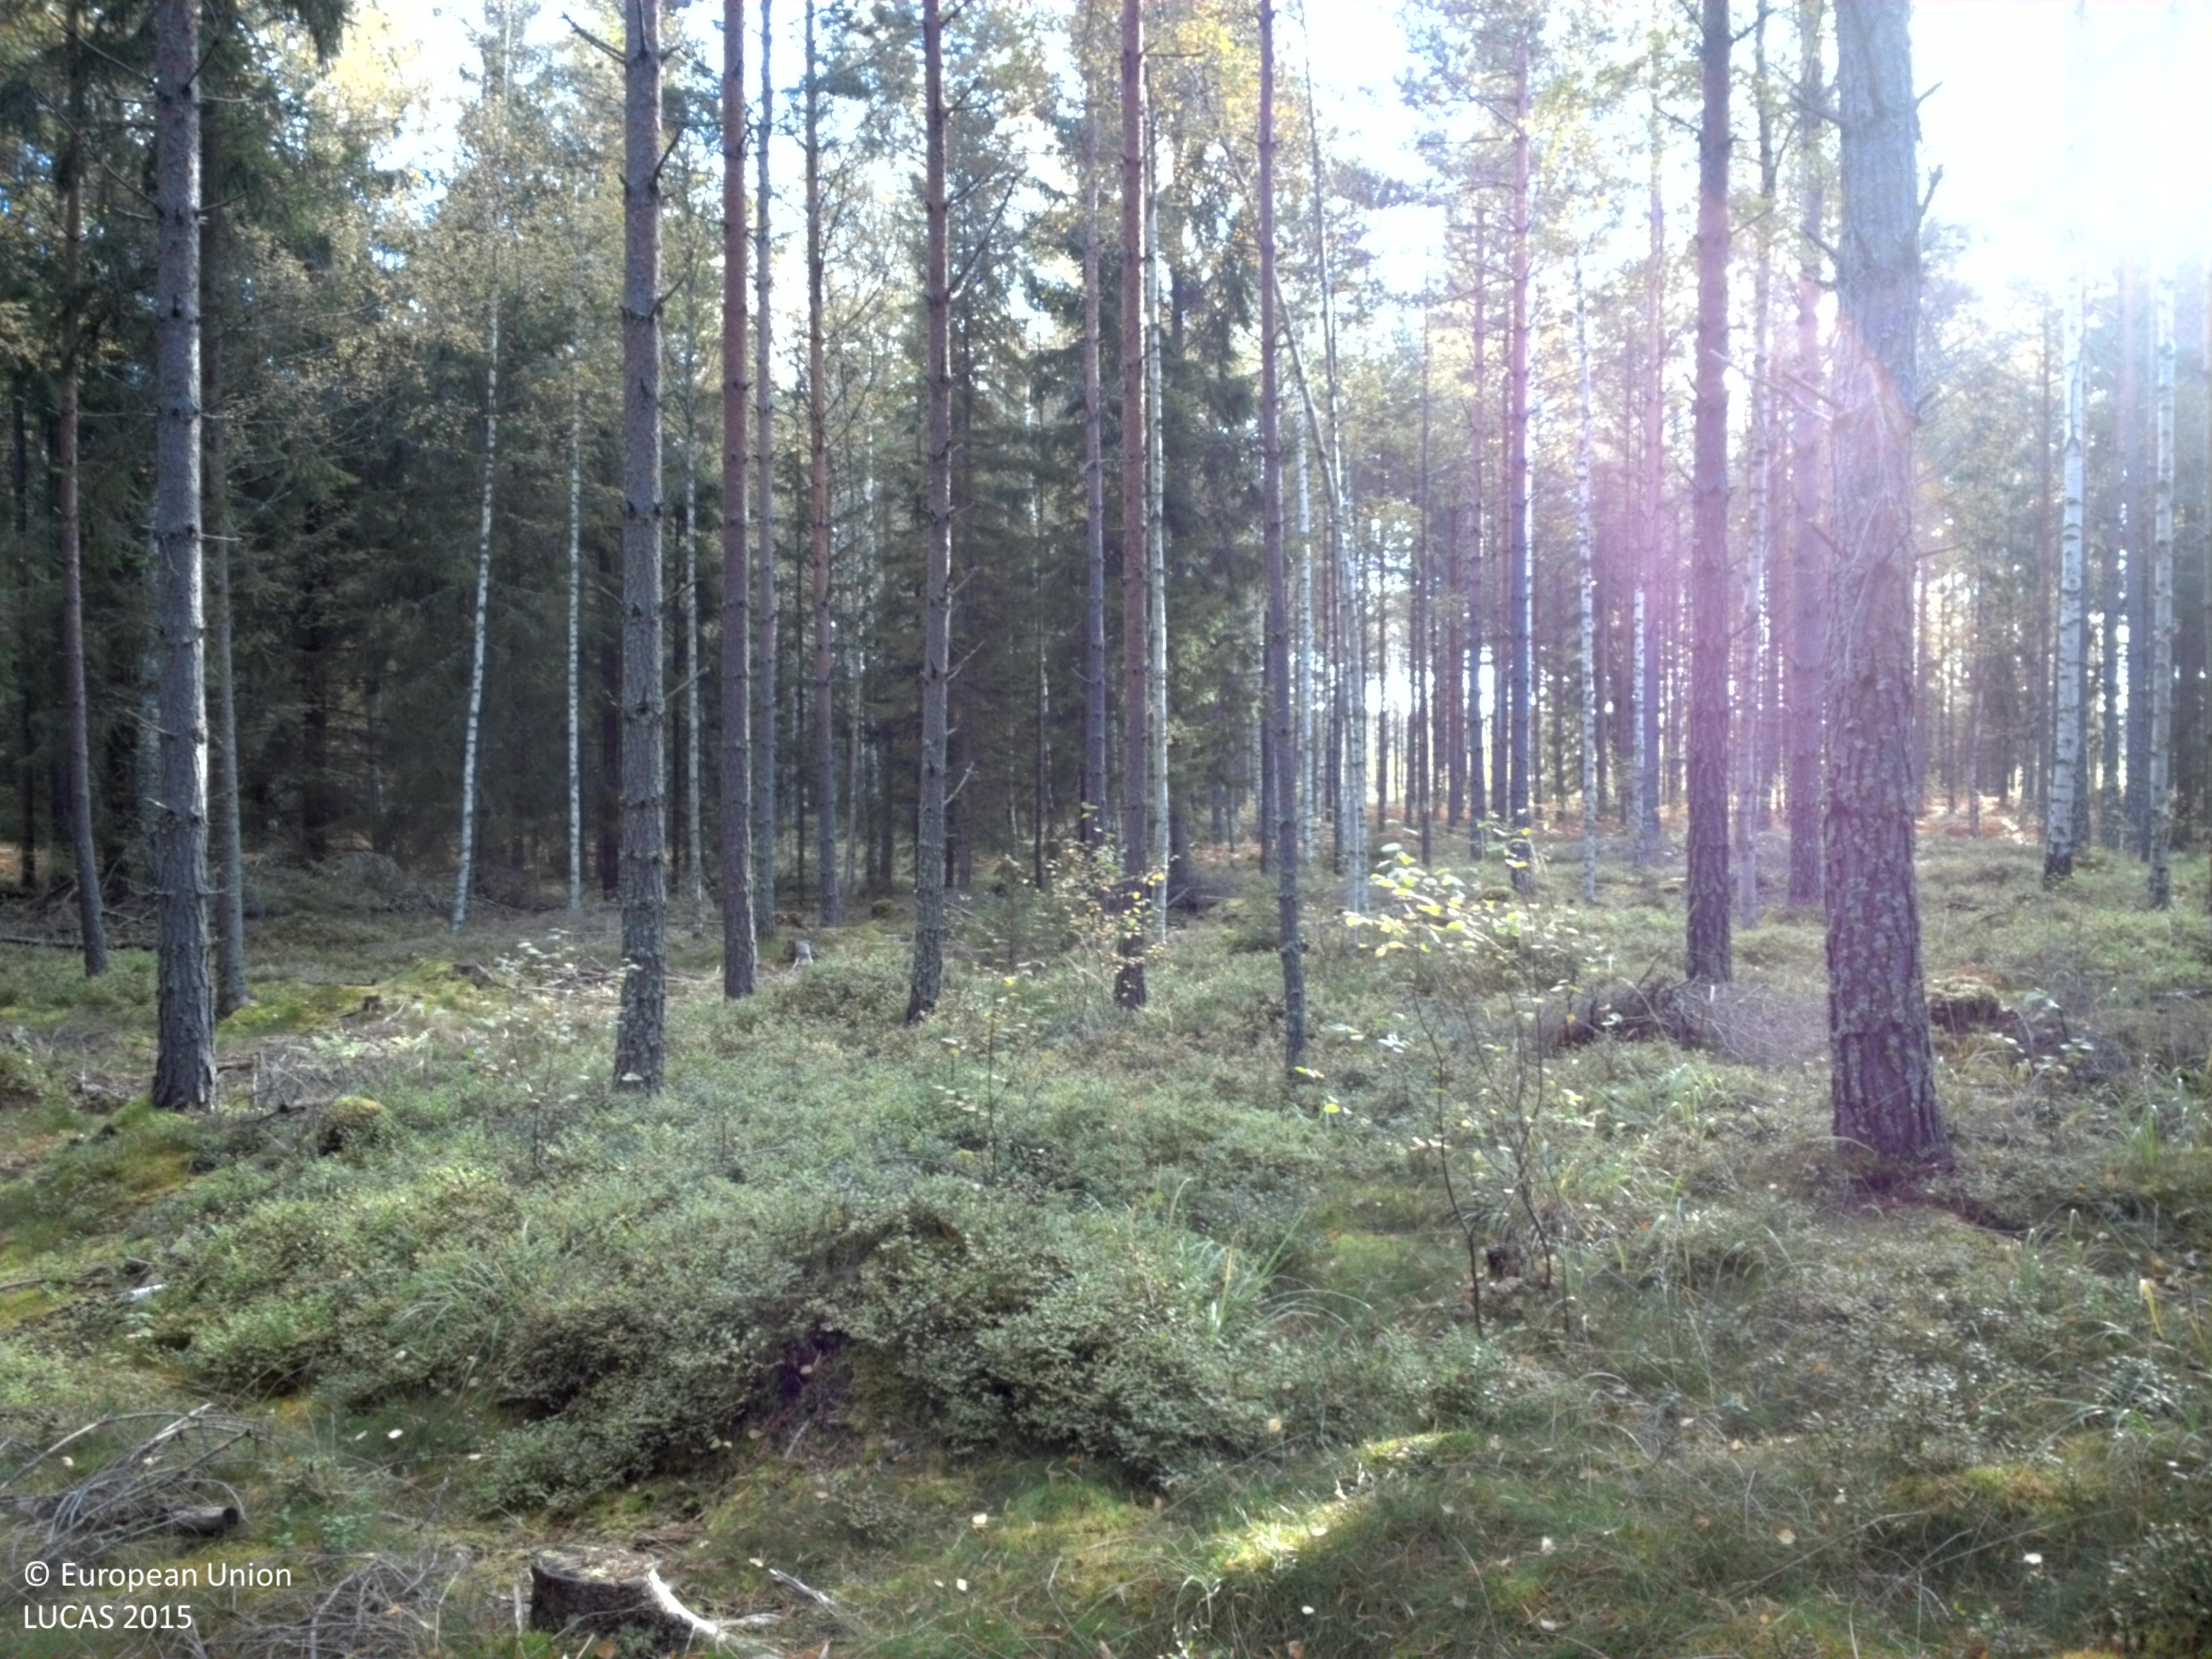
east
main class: Woodland
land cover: Pine dominated coniferous woodland
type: boreal forest
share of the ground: 50 - 75 %
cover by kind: coniferous forest trees 60 %, herbaceous plants 15 %, lichens and mosses 15 %, broadleaved forest trees 10 %
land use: Forestry
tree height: > 5 m
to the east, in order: Pine dominated coniferous woodland; Pine dominated mixed woodland; Tracks; Other coniferous woodland; Grass margins; Paved roads, cycling and walking lanes; Grass margins; Spruce dominated coniferous woodland; Spruce dominated mixed woodland; Spruce dominated coniferous woodland
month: September
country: SE
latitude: 60.0127
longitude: 16.5017
